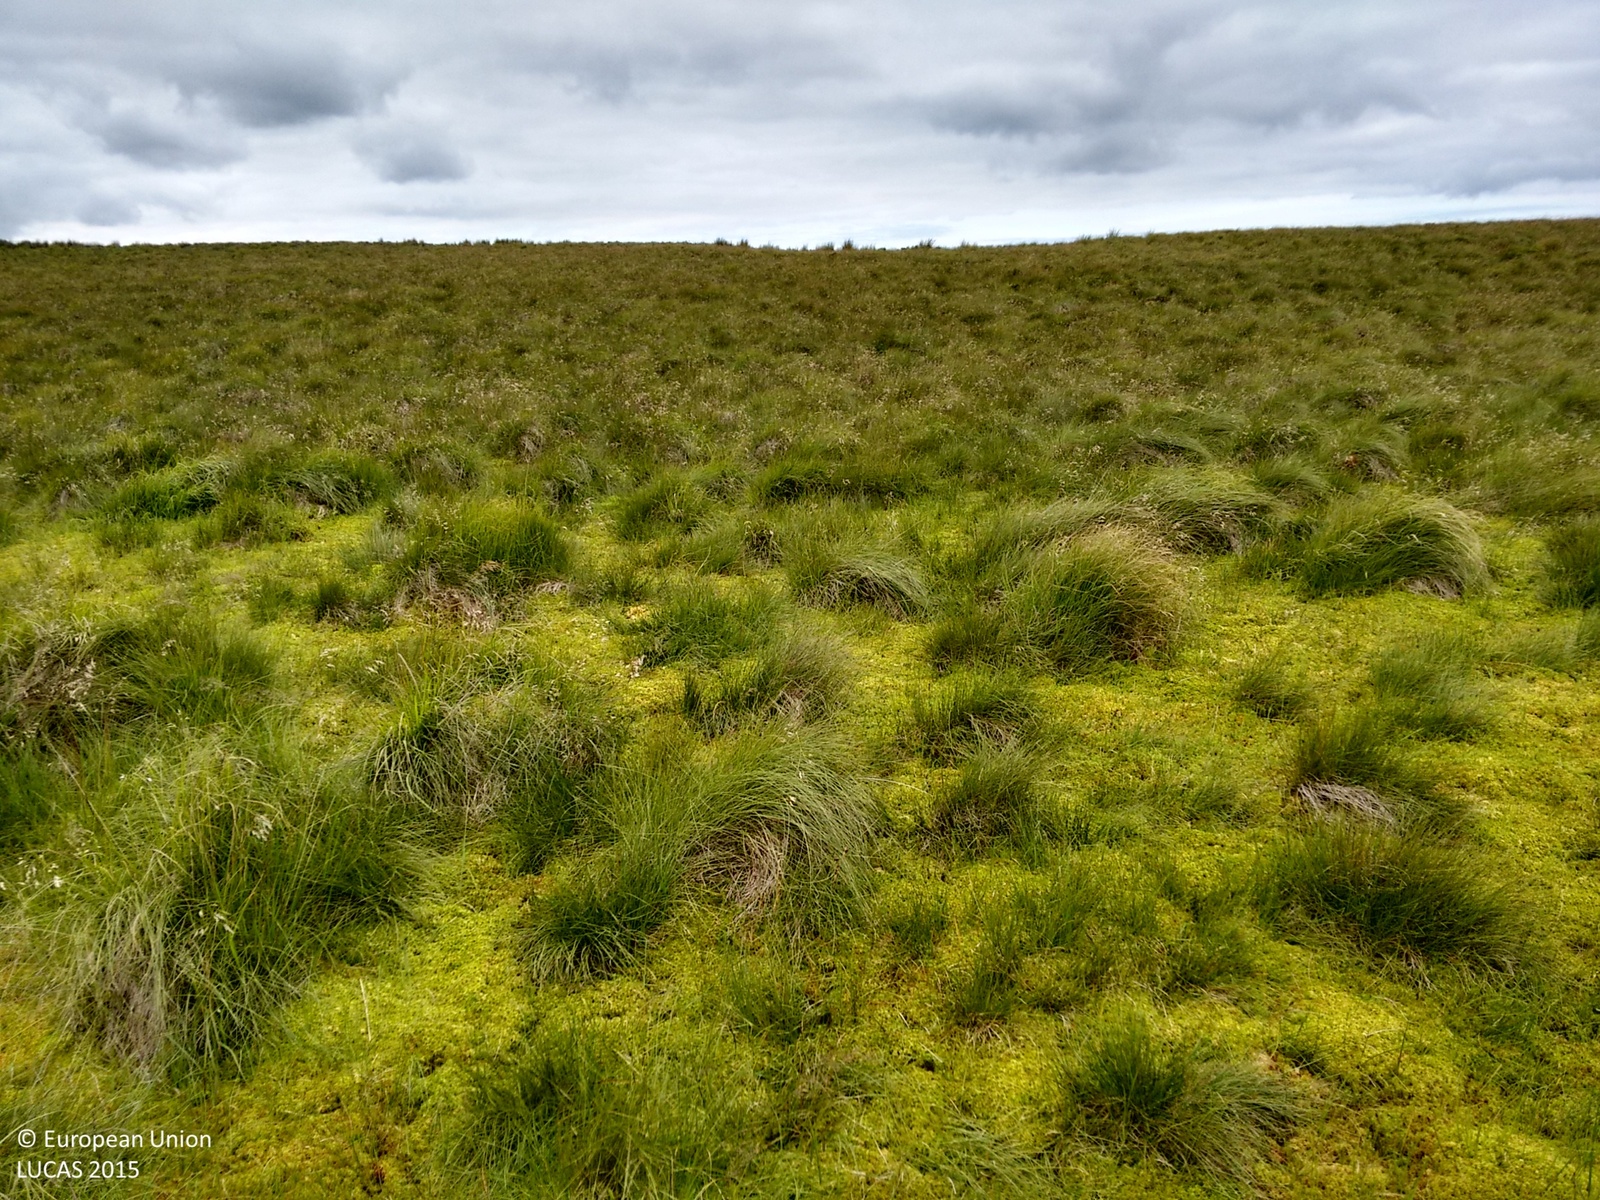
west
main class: Grassland
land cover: Grassland without tree/shrub cover
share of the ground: > 75 %
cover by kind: herbaceous plants 70 %, lichens and mosses 30 %
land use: Agriculture (excluding fallow land and kitchen gardens)
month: August
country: GB
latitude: 55.0012
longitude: -4.8843
